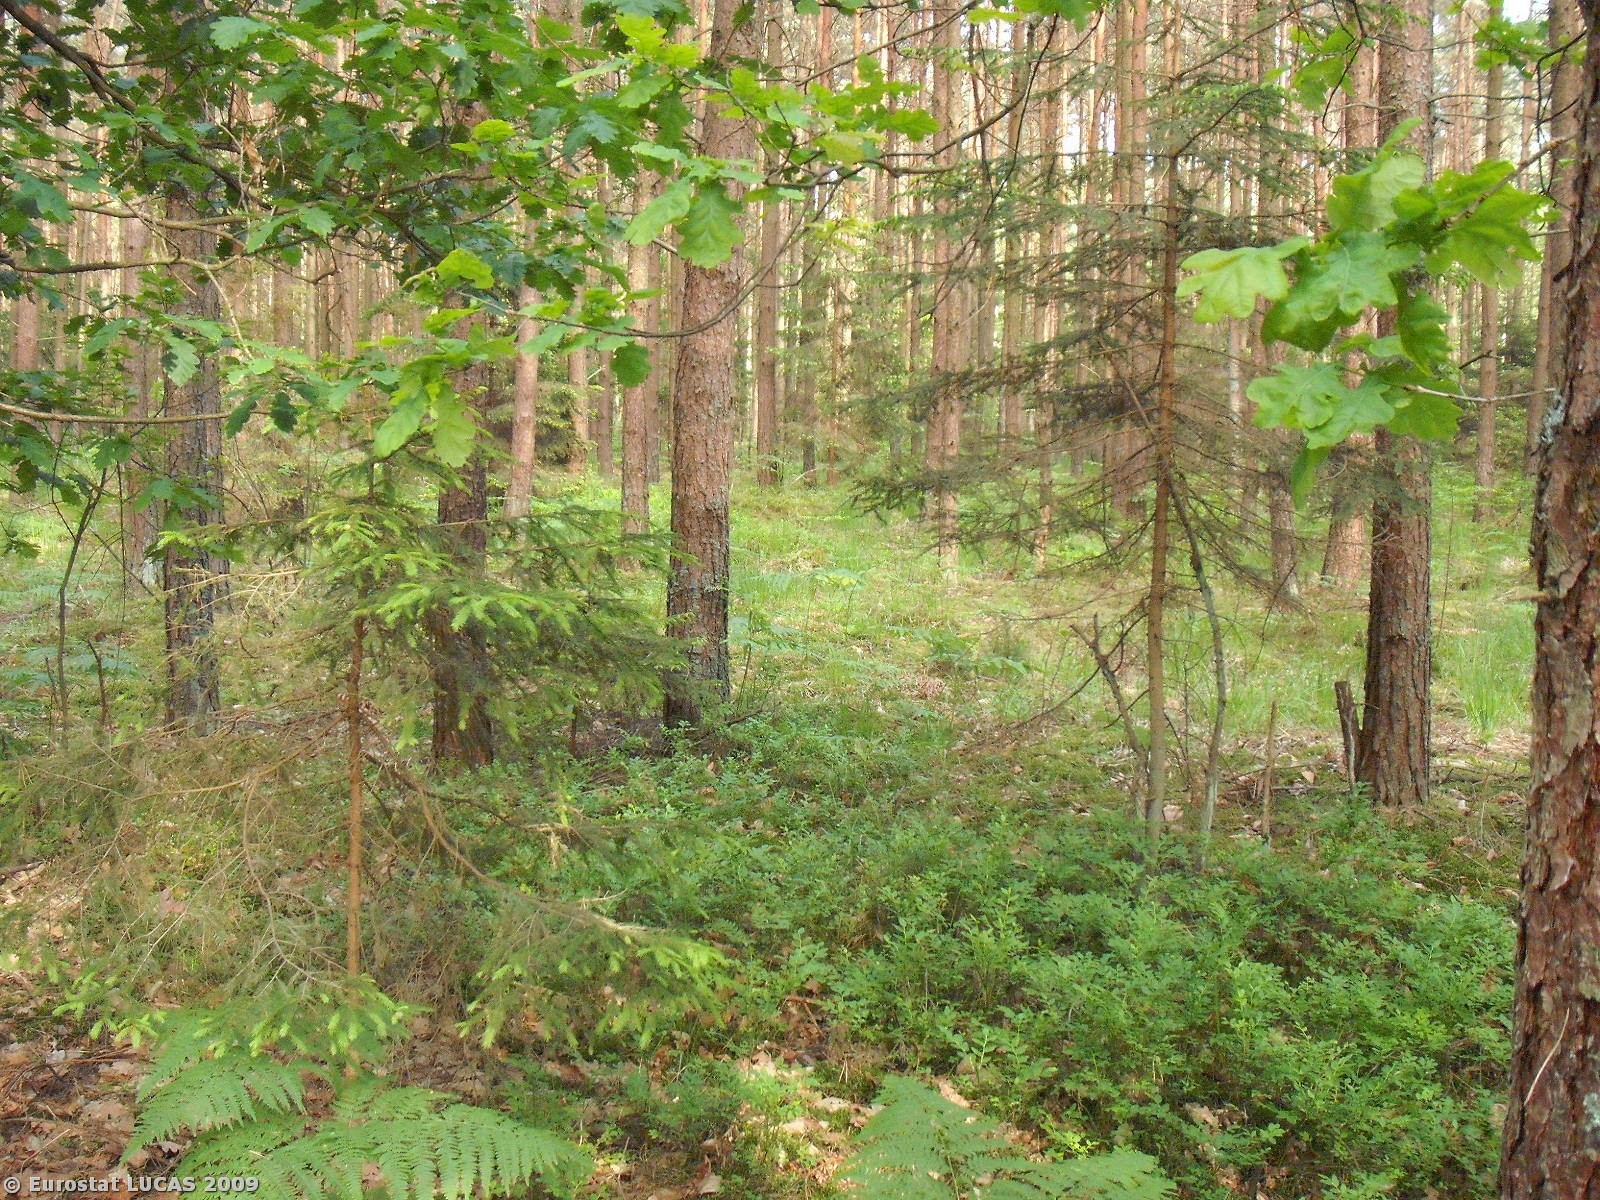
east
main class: Woodland
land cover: Coniferous woodland
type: hemiboreal forest and nemoral coniferous forest and mixed broadleaved-coniferous forest
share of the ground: > 75 %
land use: Forestry
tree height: > 5 m
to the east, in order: Coniferous woodland; Ditches and canals; Paved roads, cycling and walking lanes; Ditches and canals; Mixed woodland
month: June
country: PL
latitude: 51.3301
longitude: 20.5010
